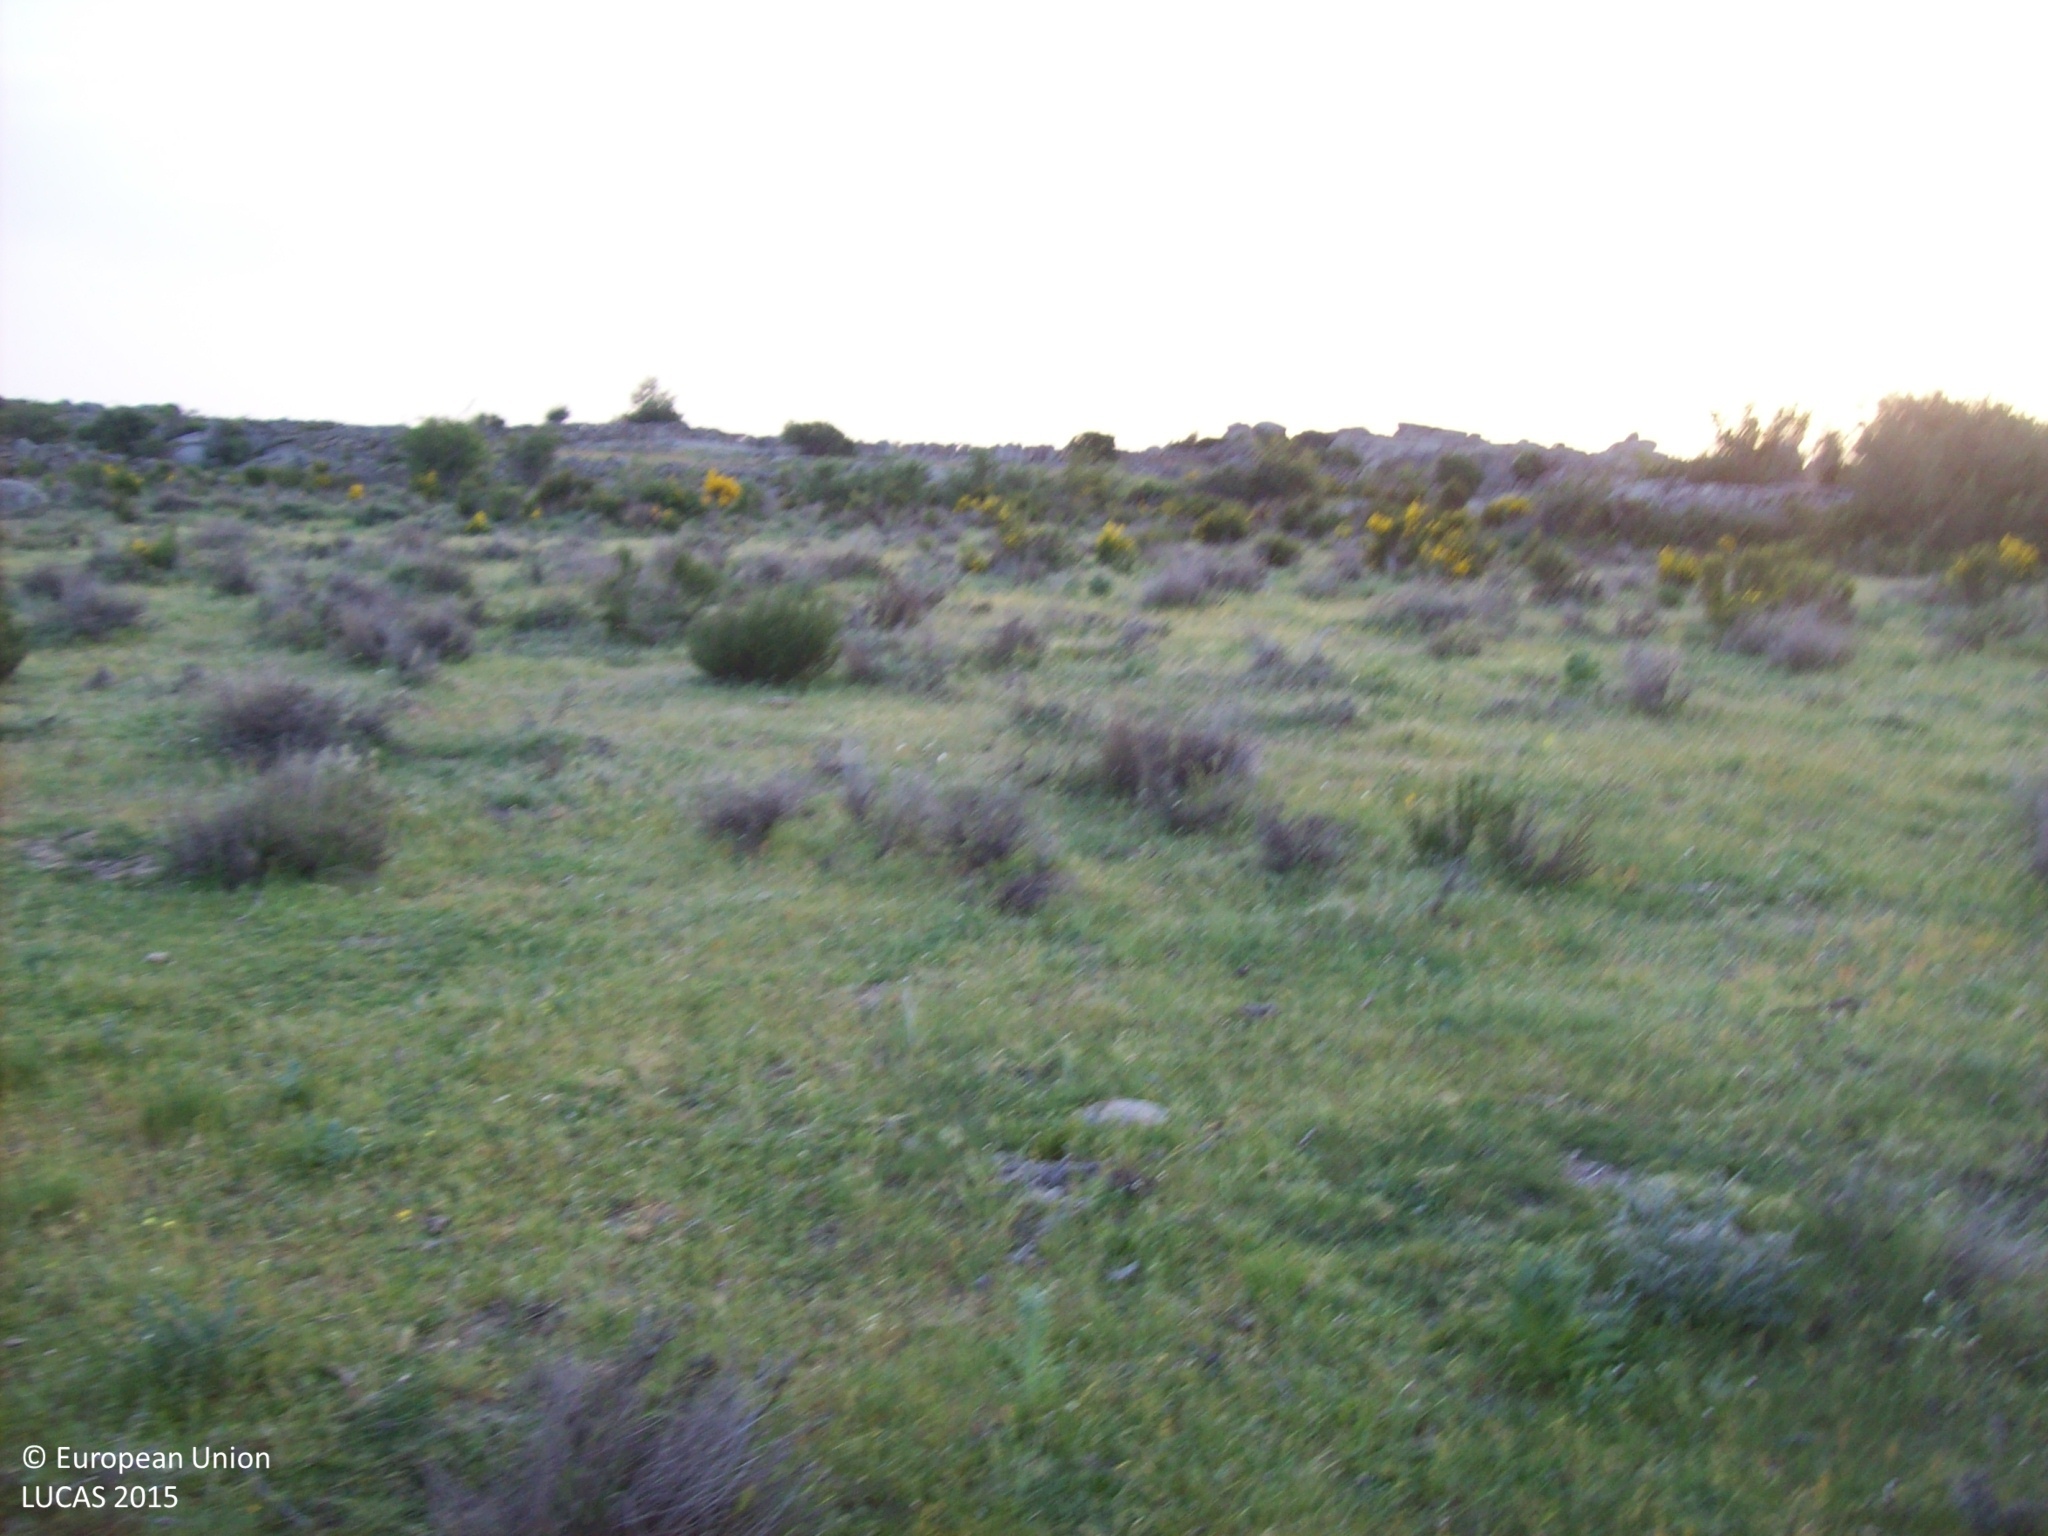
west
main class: Shrubland
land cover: Shrubland without tree cover
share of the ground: 25 - 50 %
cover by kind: herbaceous plants 65 %, shrubs 30 %, consolidated bare surface 5 %
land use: Agriculture (excluding fallow land and kitchen gardens)
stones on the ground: < 10 %
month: May
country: ES
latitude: 40.6921
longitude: -4.9589
